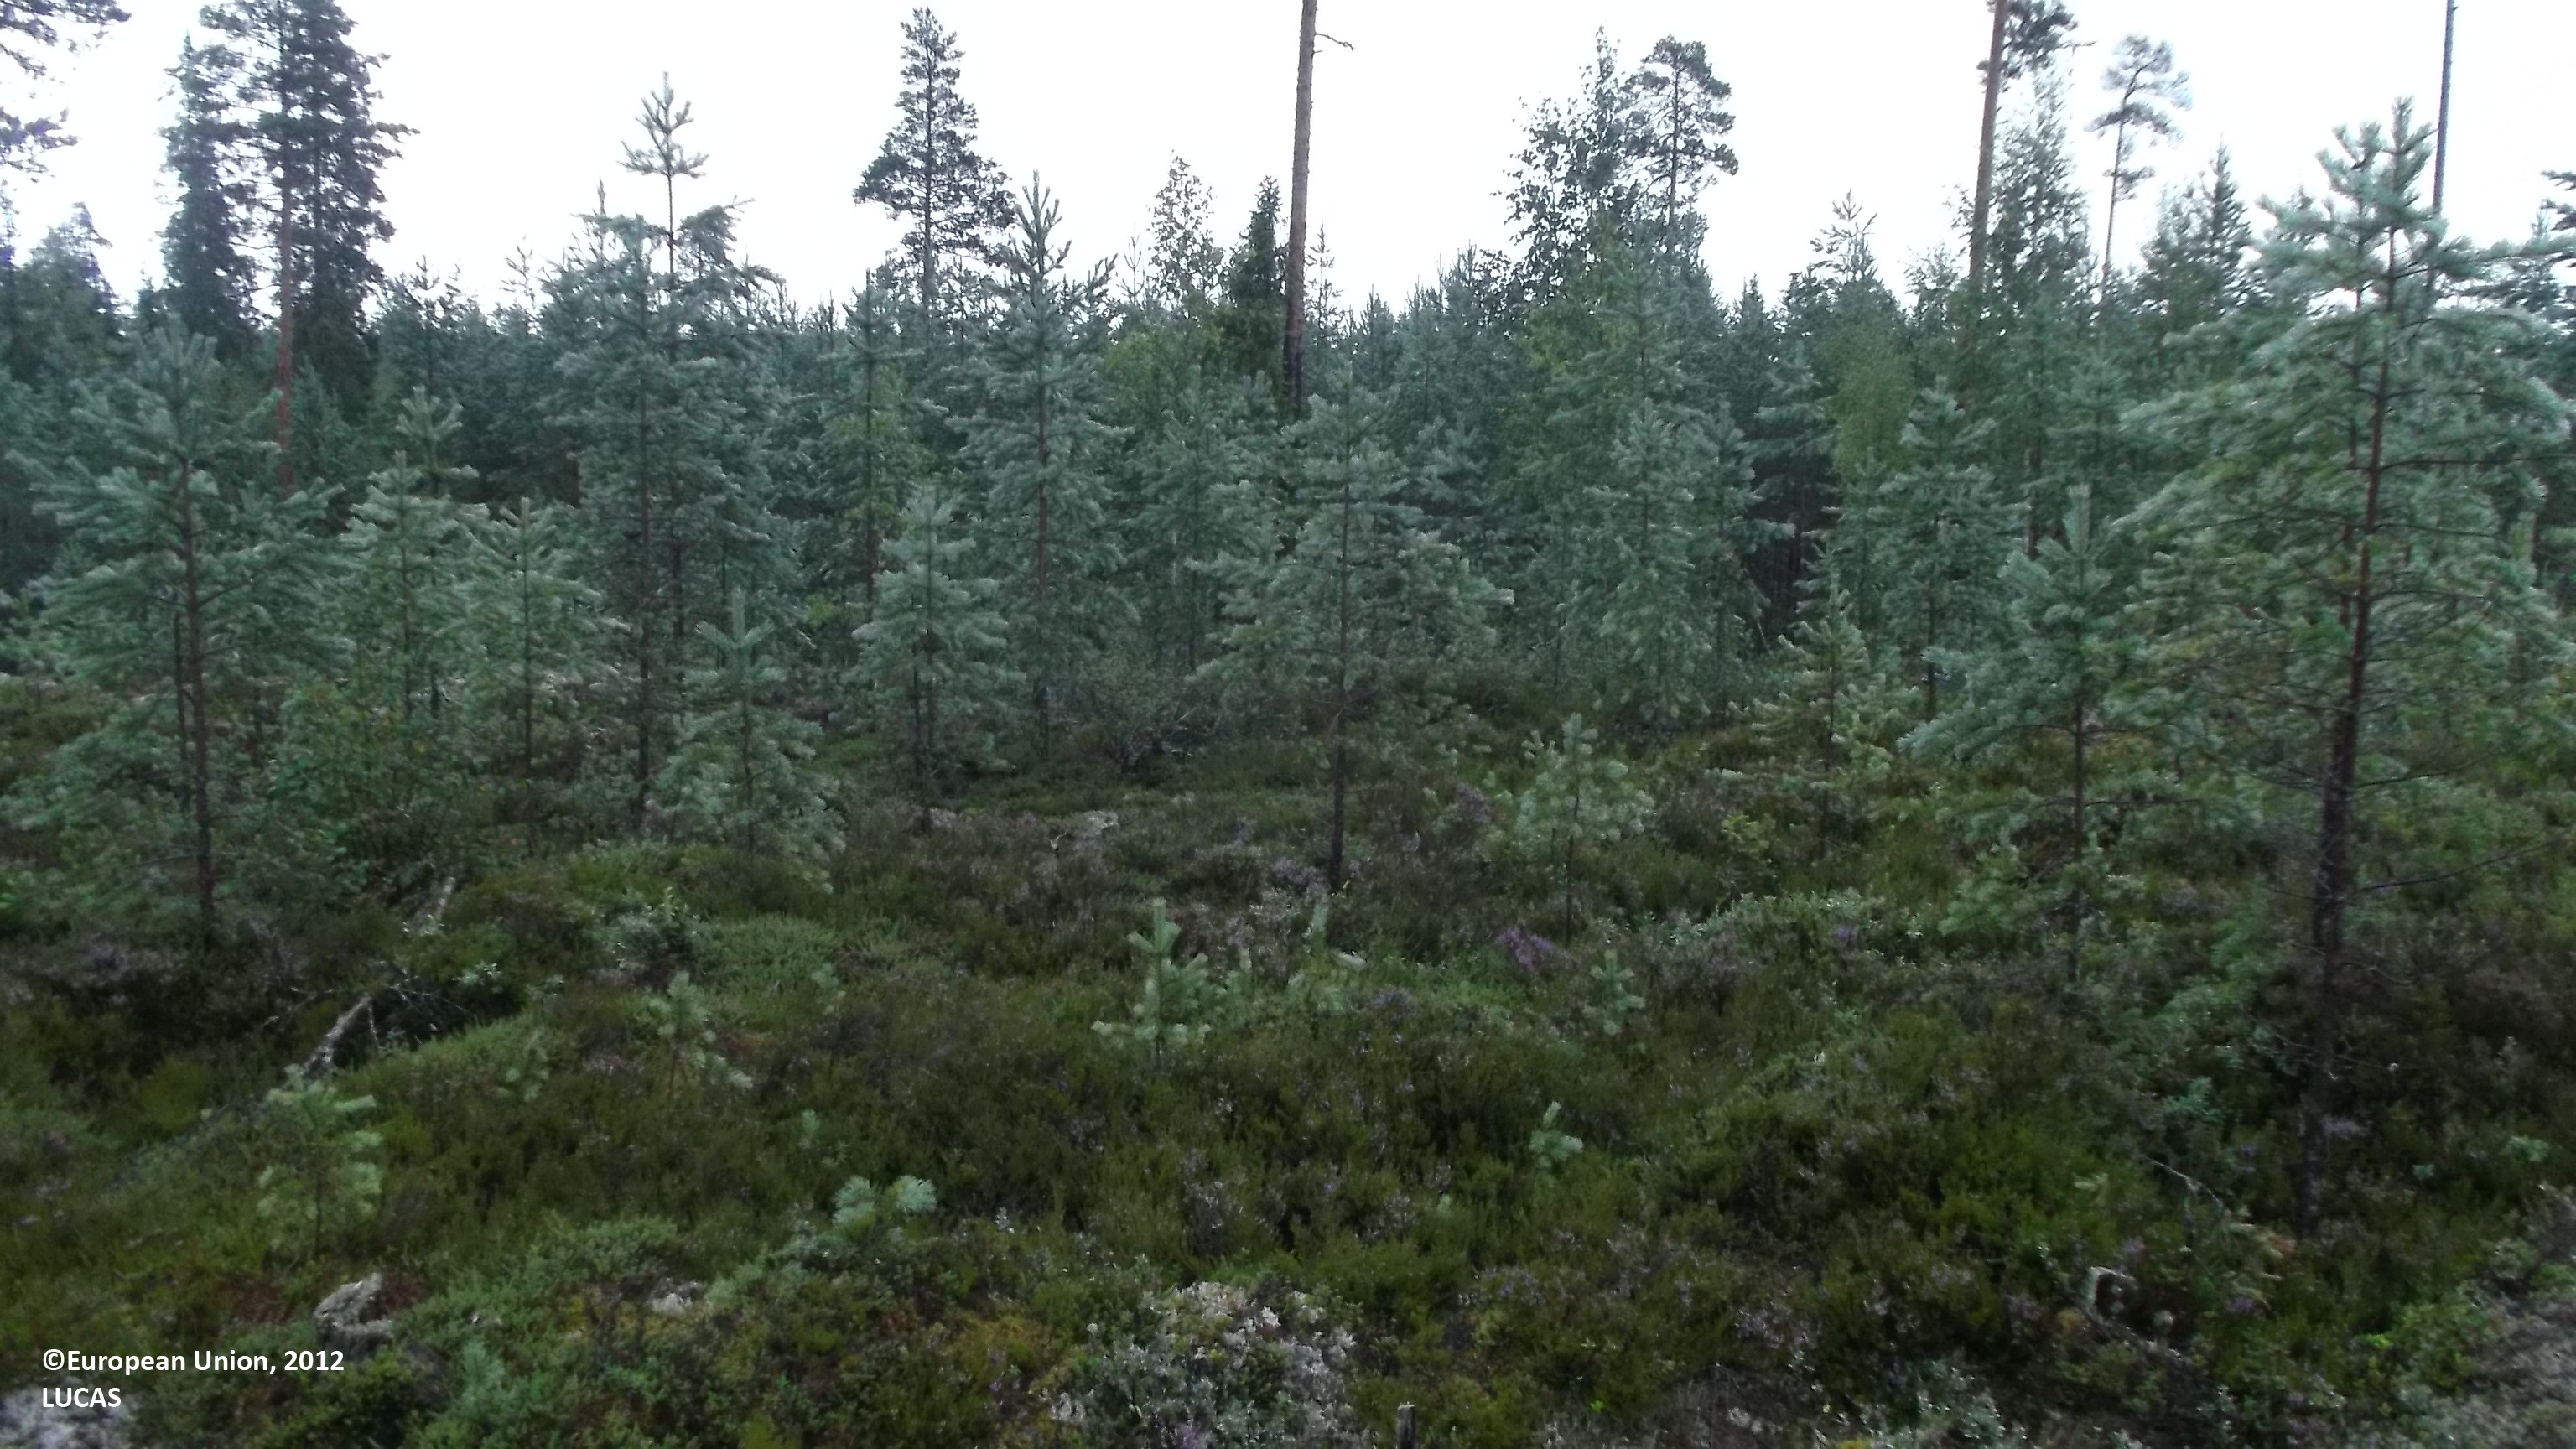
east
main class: Woodland
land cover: Pine dominated coniferous woodland
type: boreal forest
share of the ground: 10 - 25 %
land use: Forestry
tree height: < 5 m
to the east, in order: Pine dominated coniferous woodland; Other mixed woodland; Ditches and canals; Pine dominated mixed woodland; Rocks and stones; Pine dominated coniferous woodland; Pine dominated mixed woodland
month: August
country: FI
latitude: 63.2343
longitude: 23.8636
